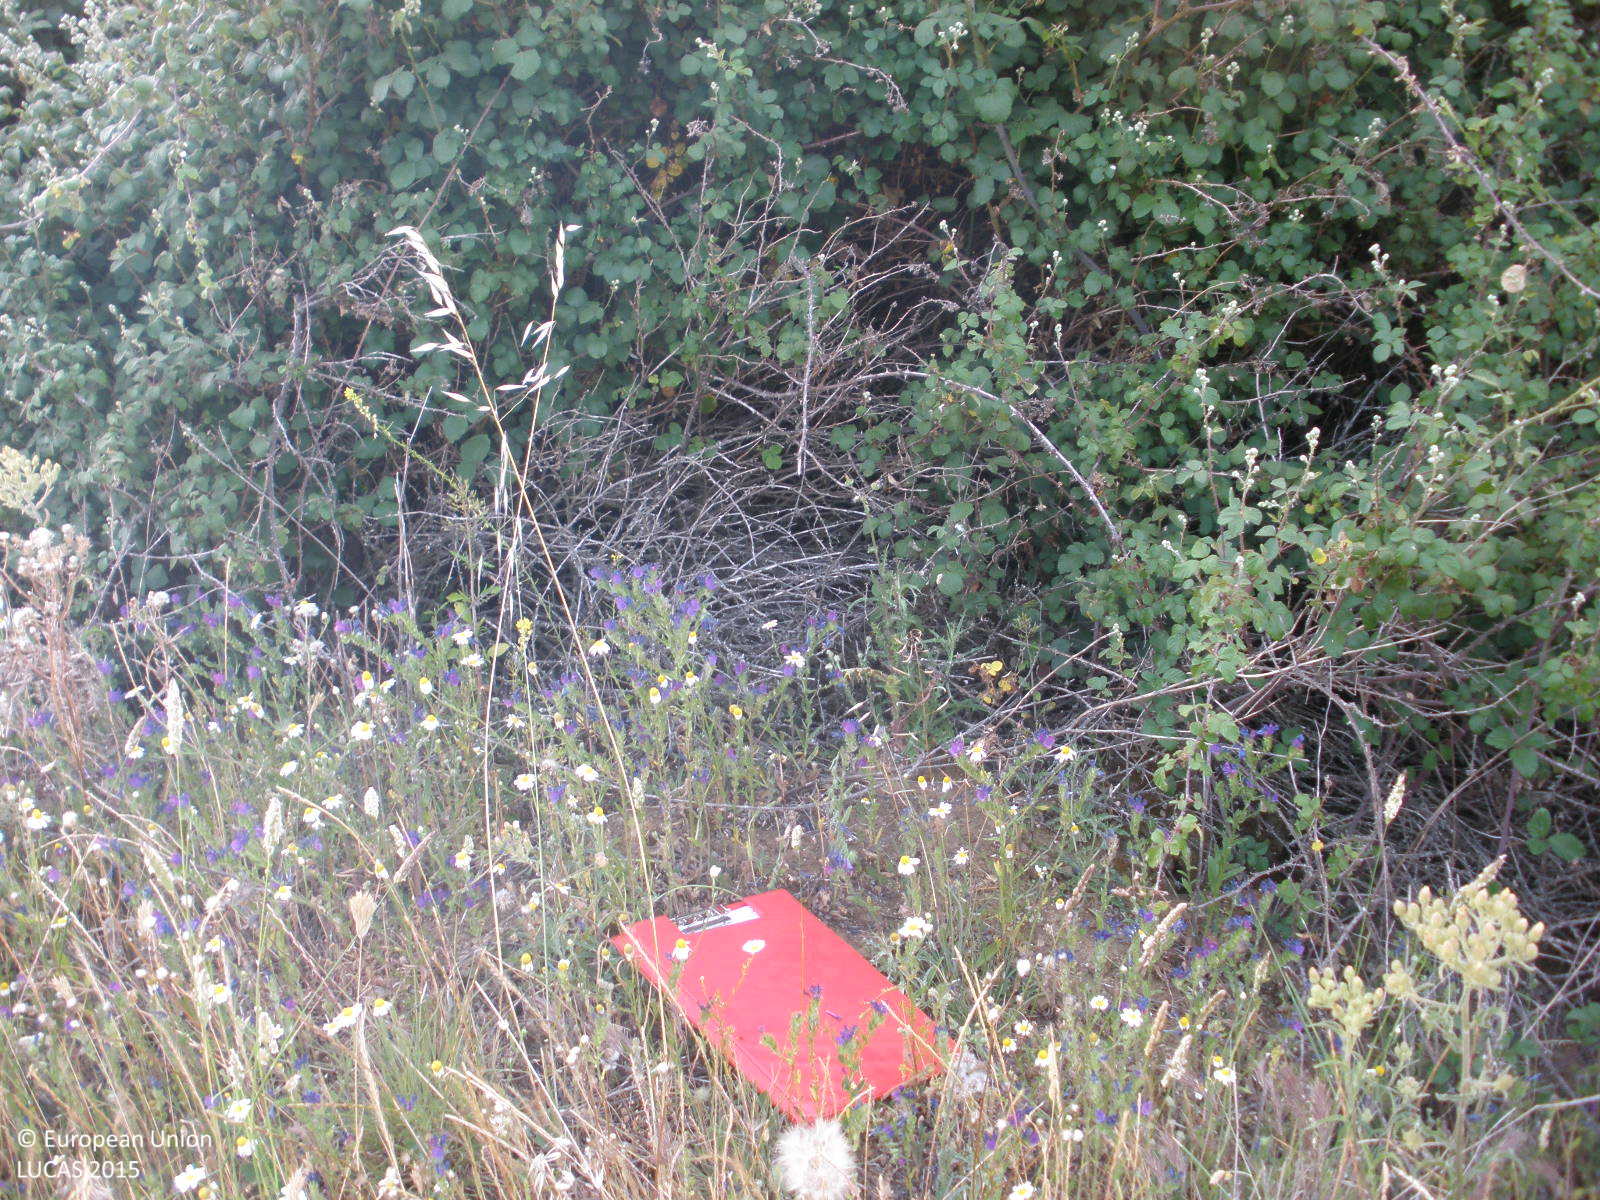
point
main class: Shrubland
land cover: Shrubland with sparse tree cover
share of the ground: > 75 %
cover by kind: shrubs 95 %, broadleaved forest trees 5 %
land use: Agriculture (excluding fallow land and kitchen gardens)
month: June
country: ES
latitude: 40.6389
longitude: -6.7557
